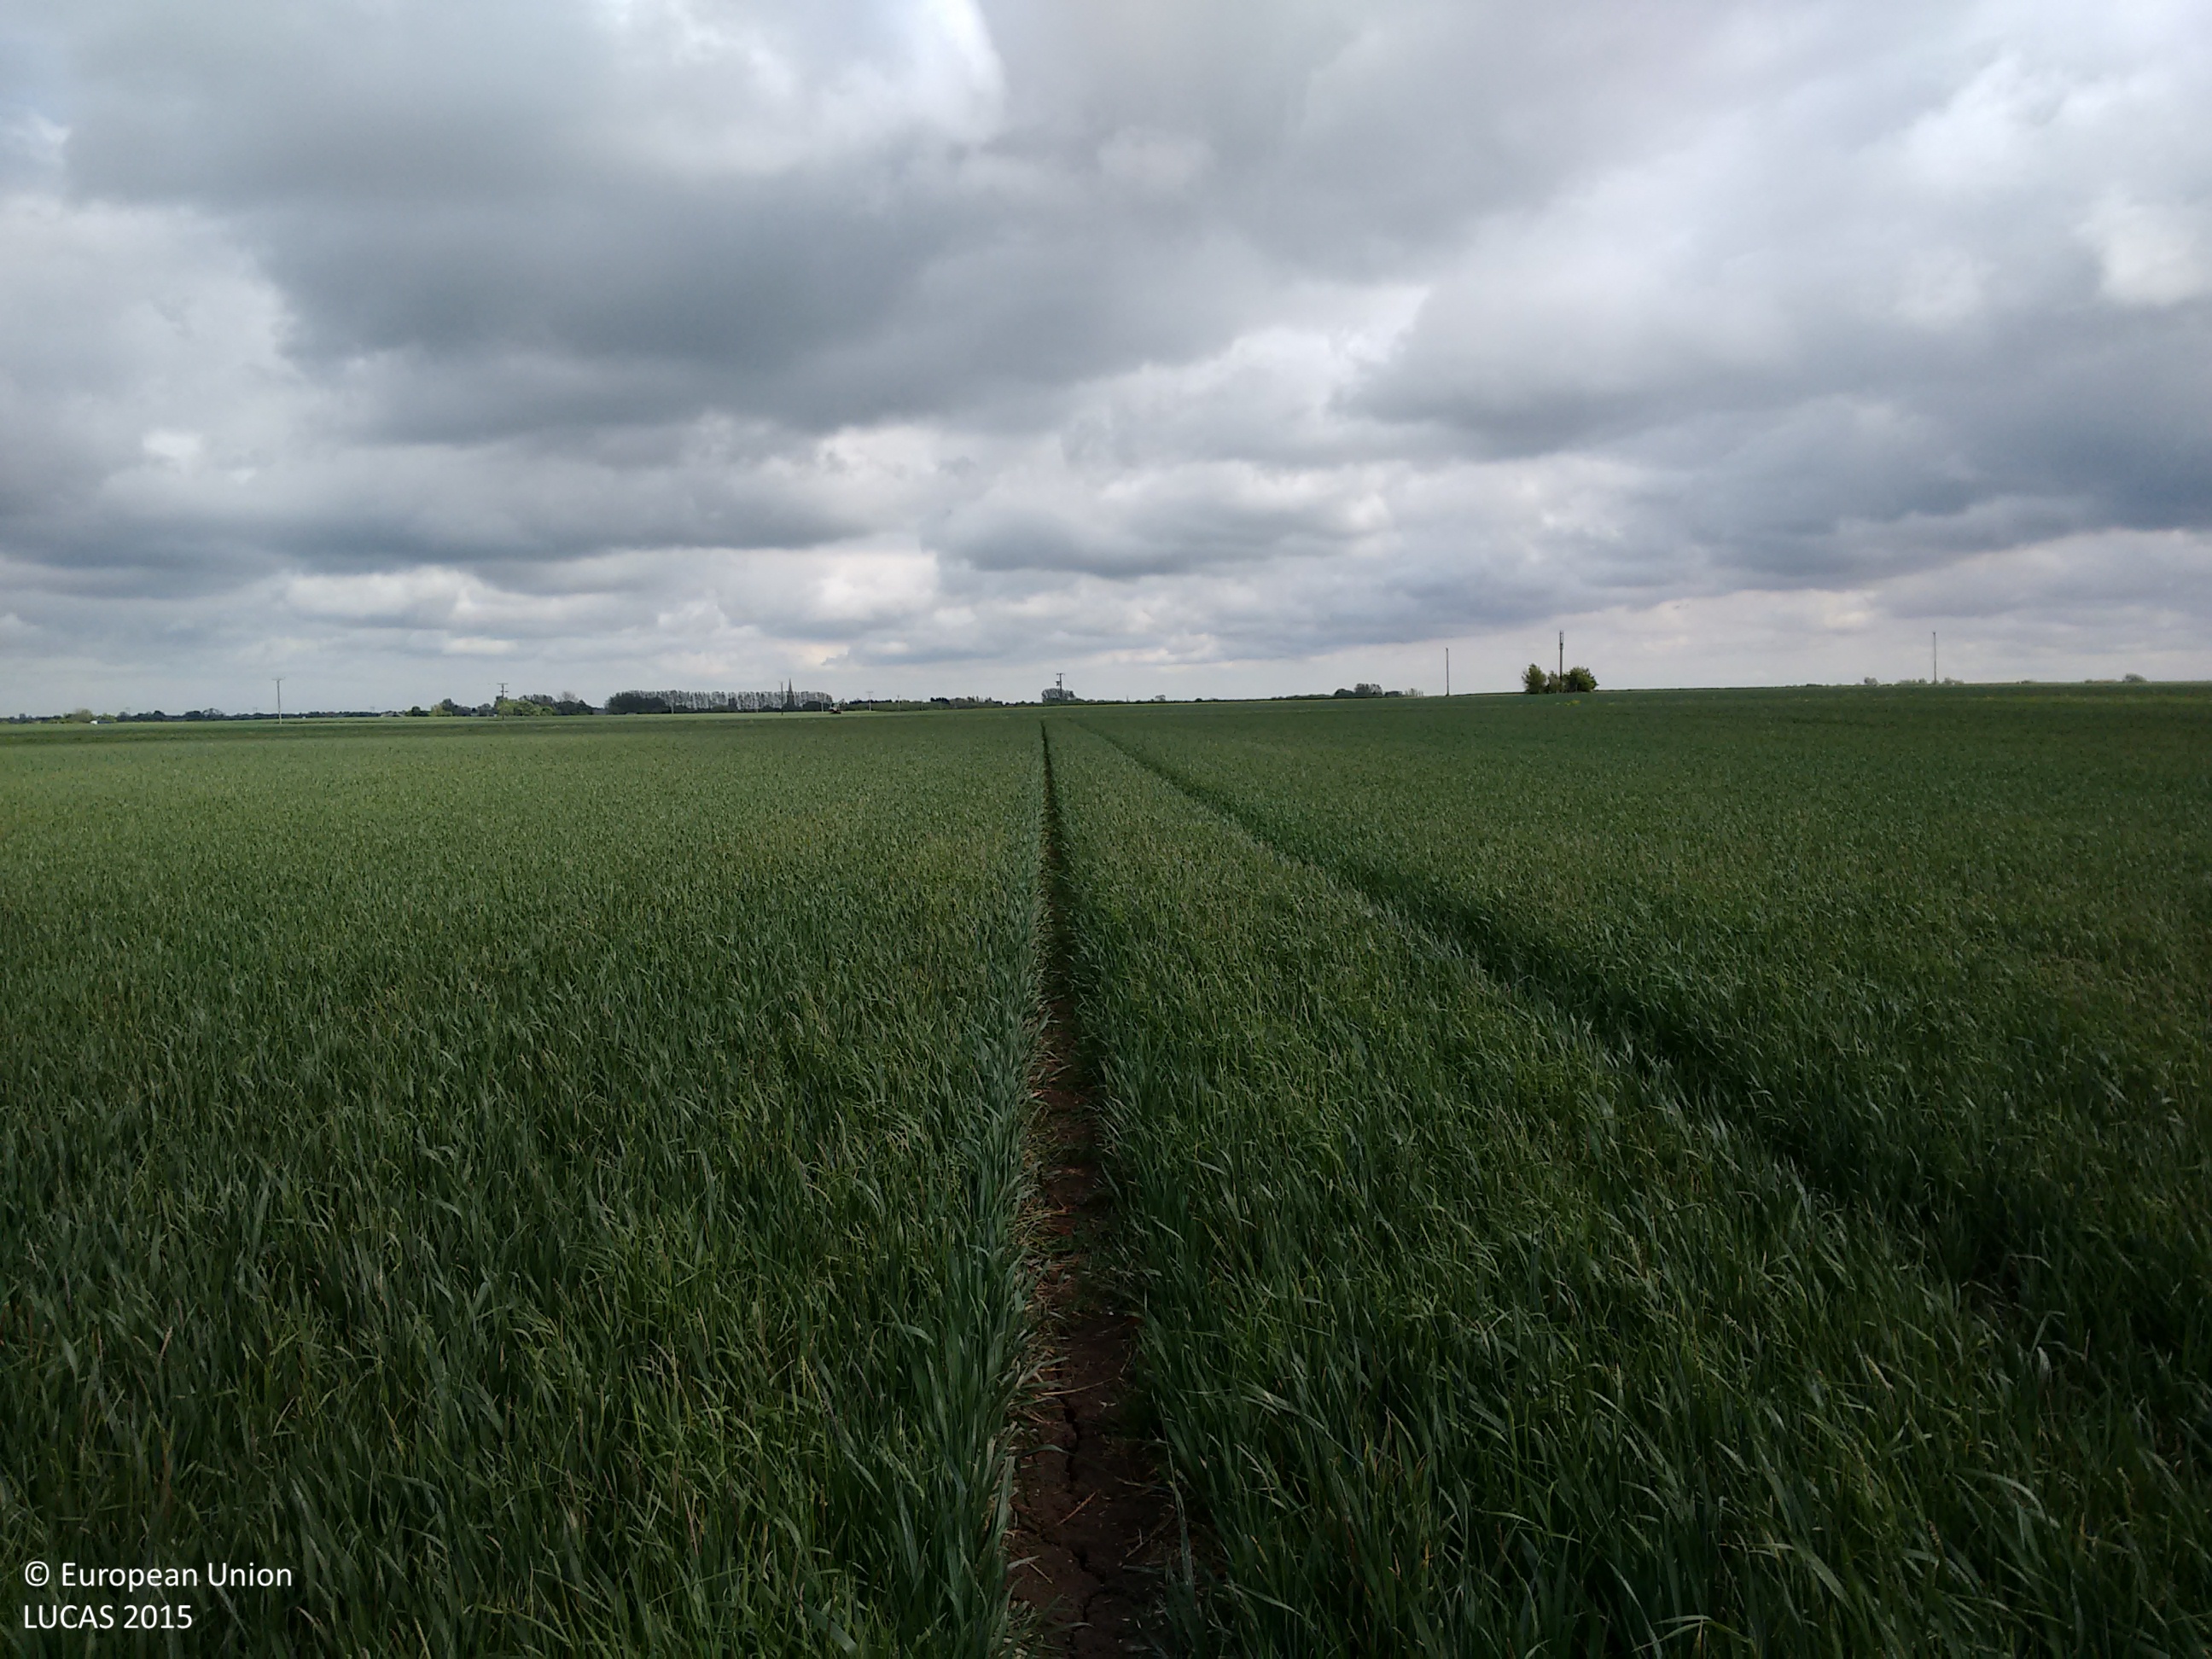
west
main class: Cropland
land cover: Common wheat
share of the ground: > 75 %
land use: Agriculture (excluding fallow land and kitchen gardens)
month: May
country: GB
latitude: 53.7031
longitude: -0.1060
